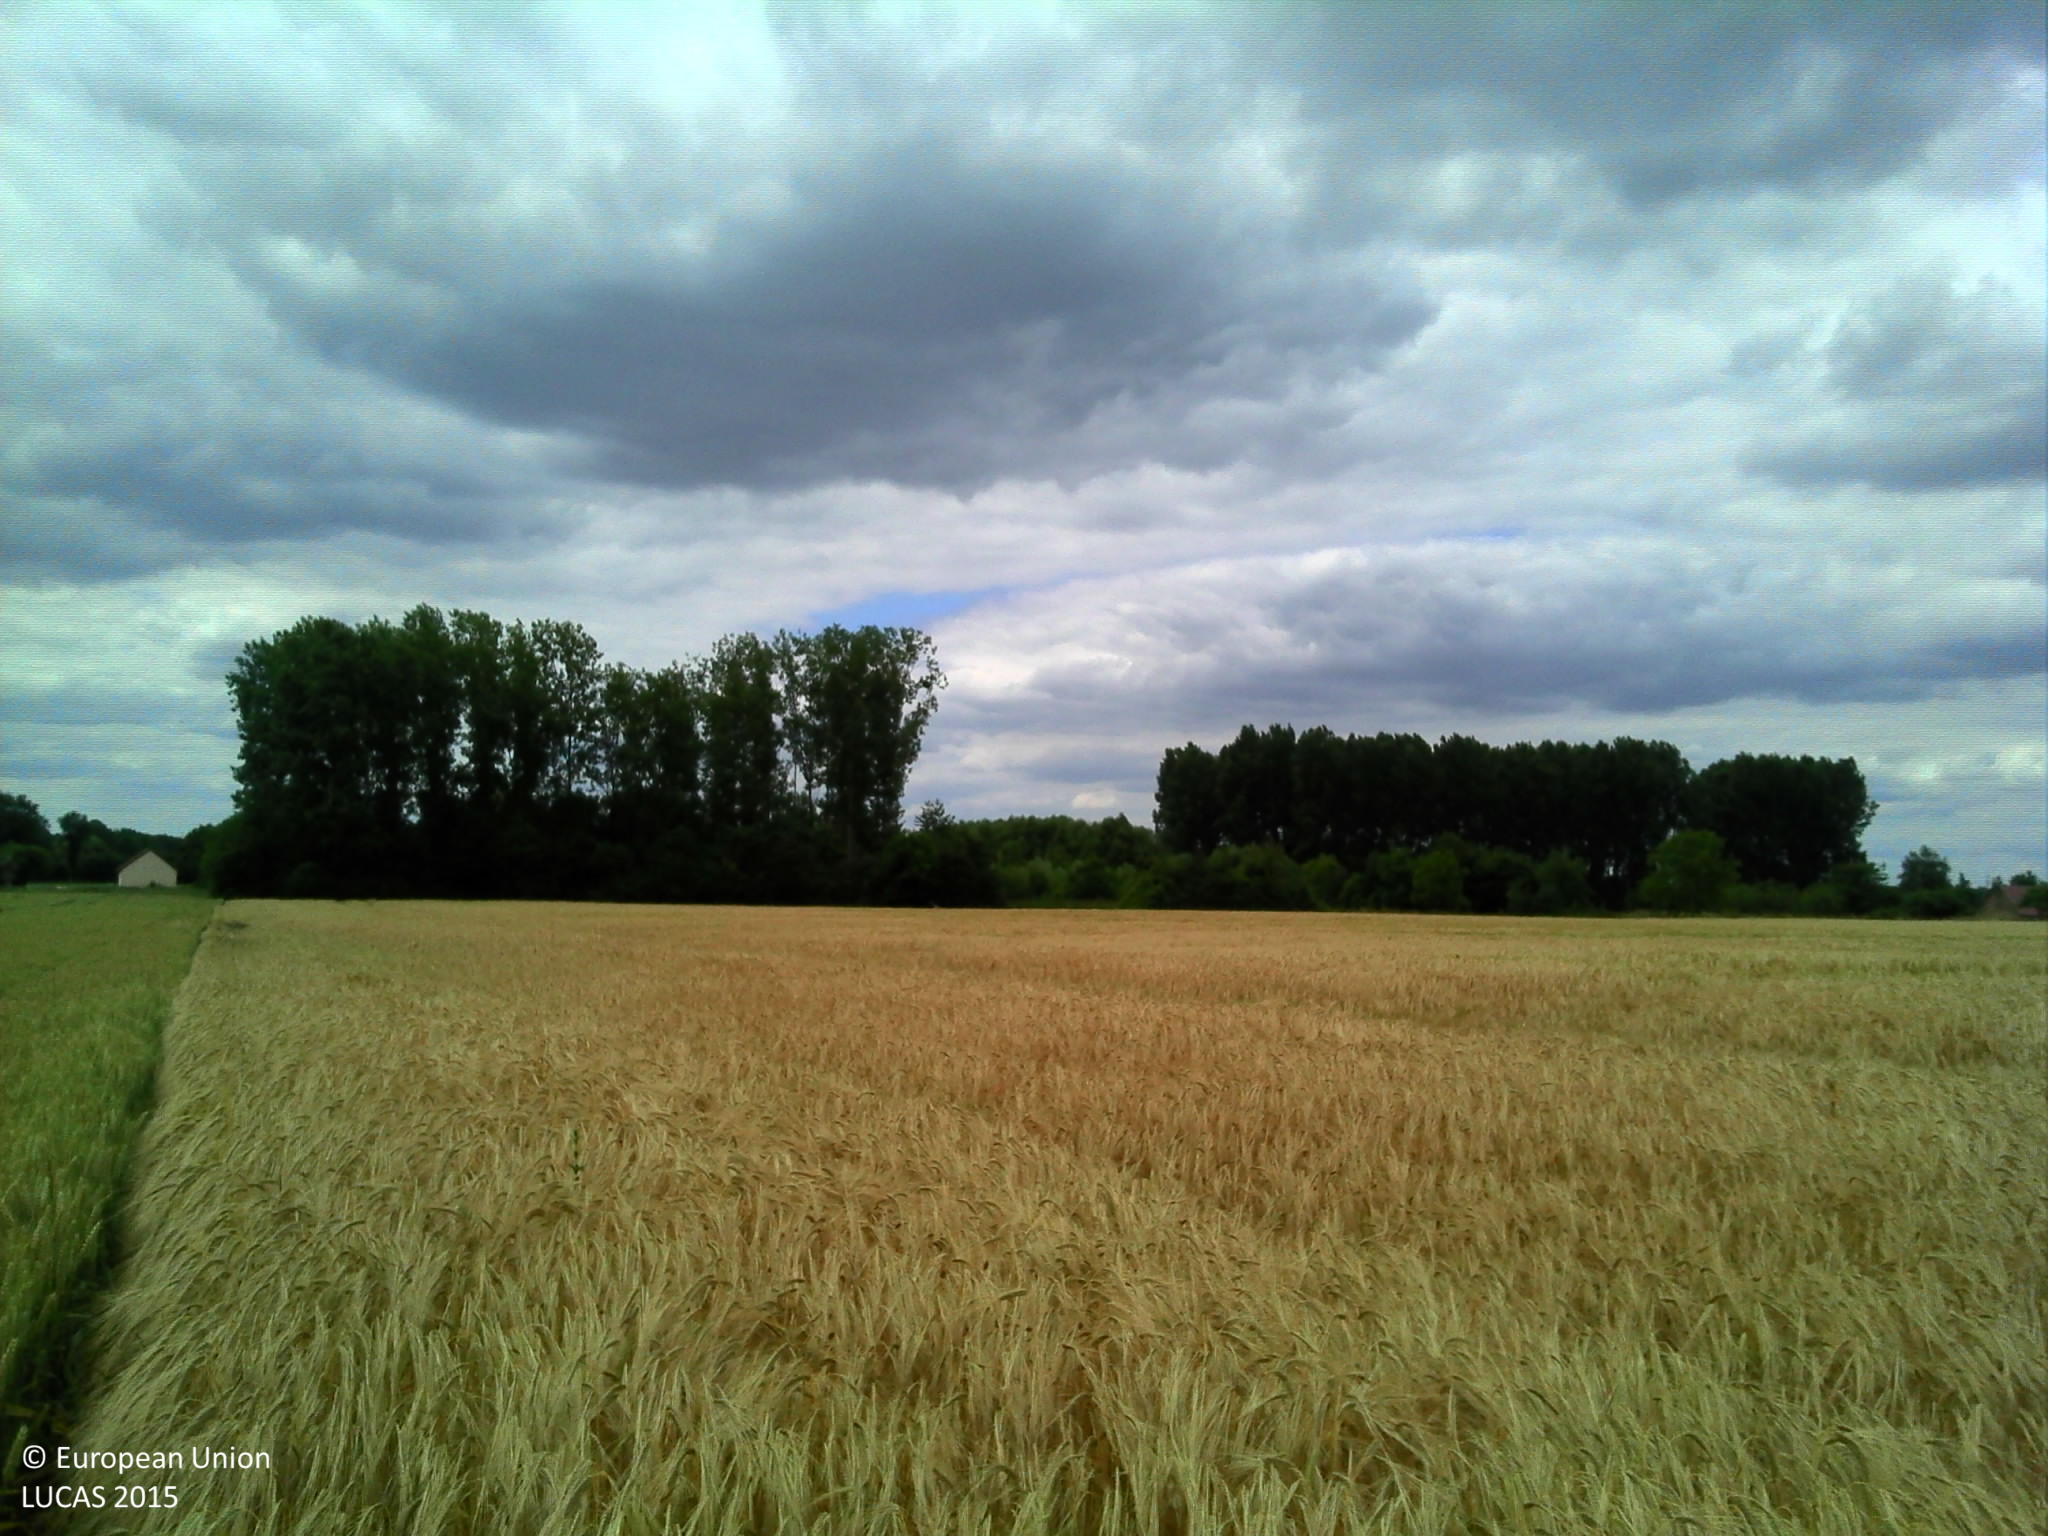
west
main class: Cropland
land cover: Common wheat
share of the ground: > 75 %
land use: Agriculture (excluding fallow land and kitchen gardens)
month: June
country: FR
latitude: 47.9039
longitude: 0.3031
